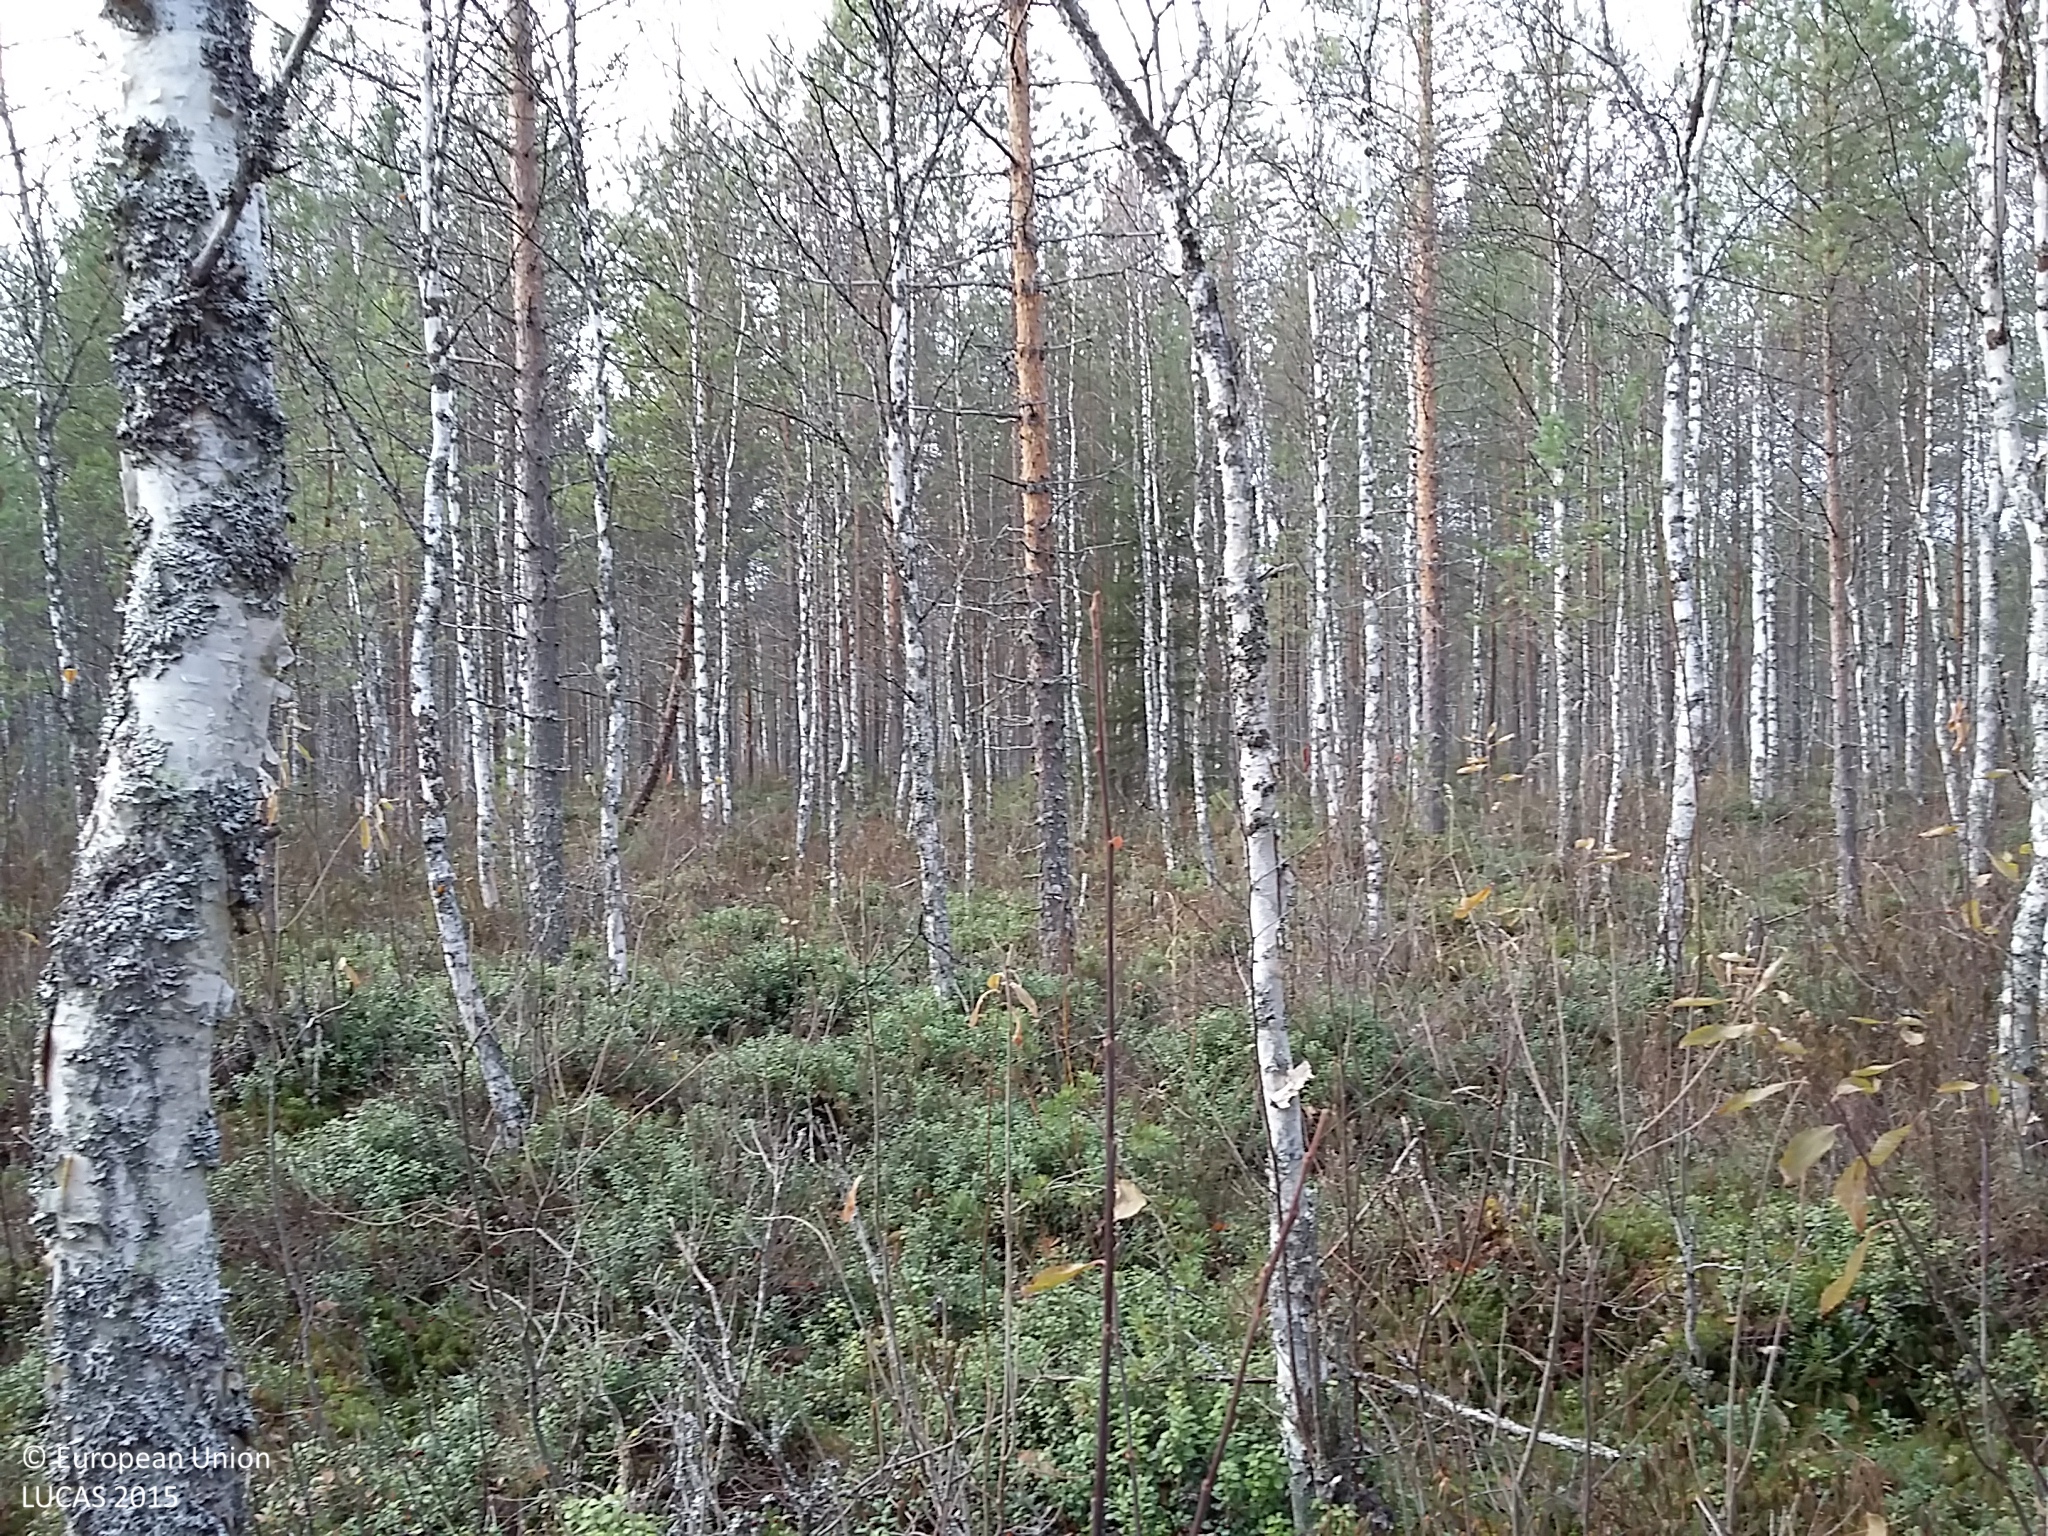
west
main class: Woodland
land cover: Pine dominated mixed woodland
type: boreal forest
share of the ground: > 75 %
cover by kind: coniferous forest trees 55 %, broadleaved forest trees 25 %, shrubs 10 %, herbaceous plants 5 %, lichens and mosses 5 %
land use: Forestry
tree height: > 5 m
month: October
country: FI
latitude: 64.6198
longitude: 25.5848
